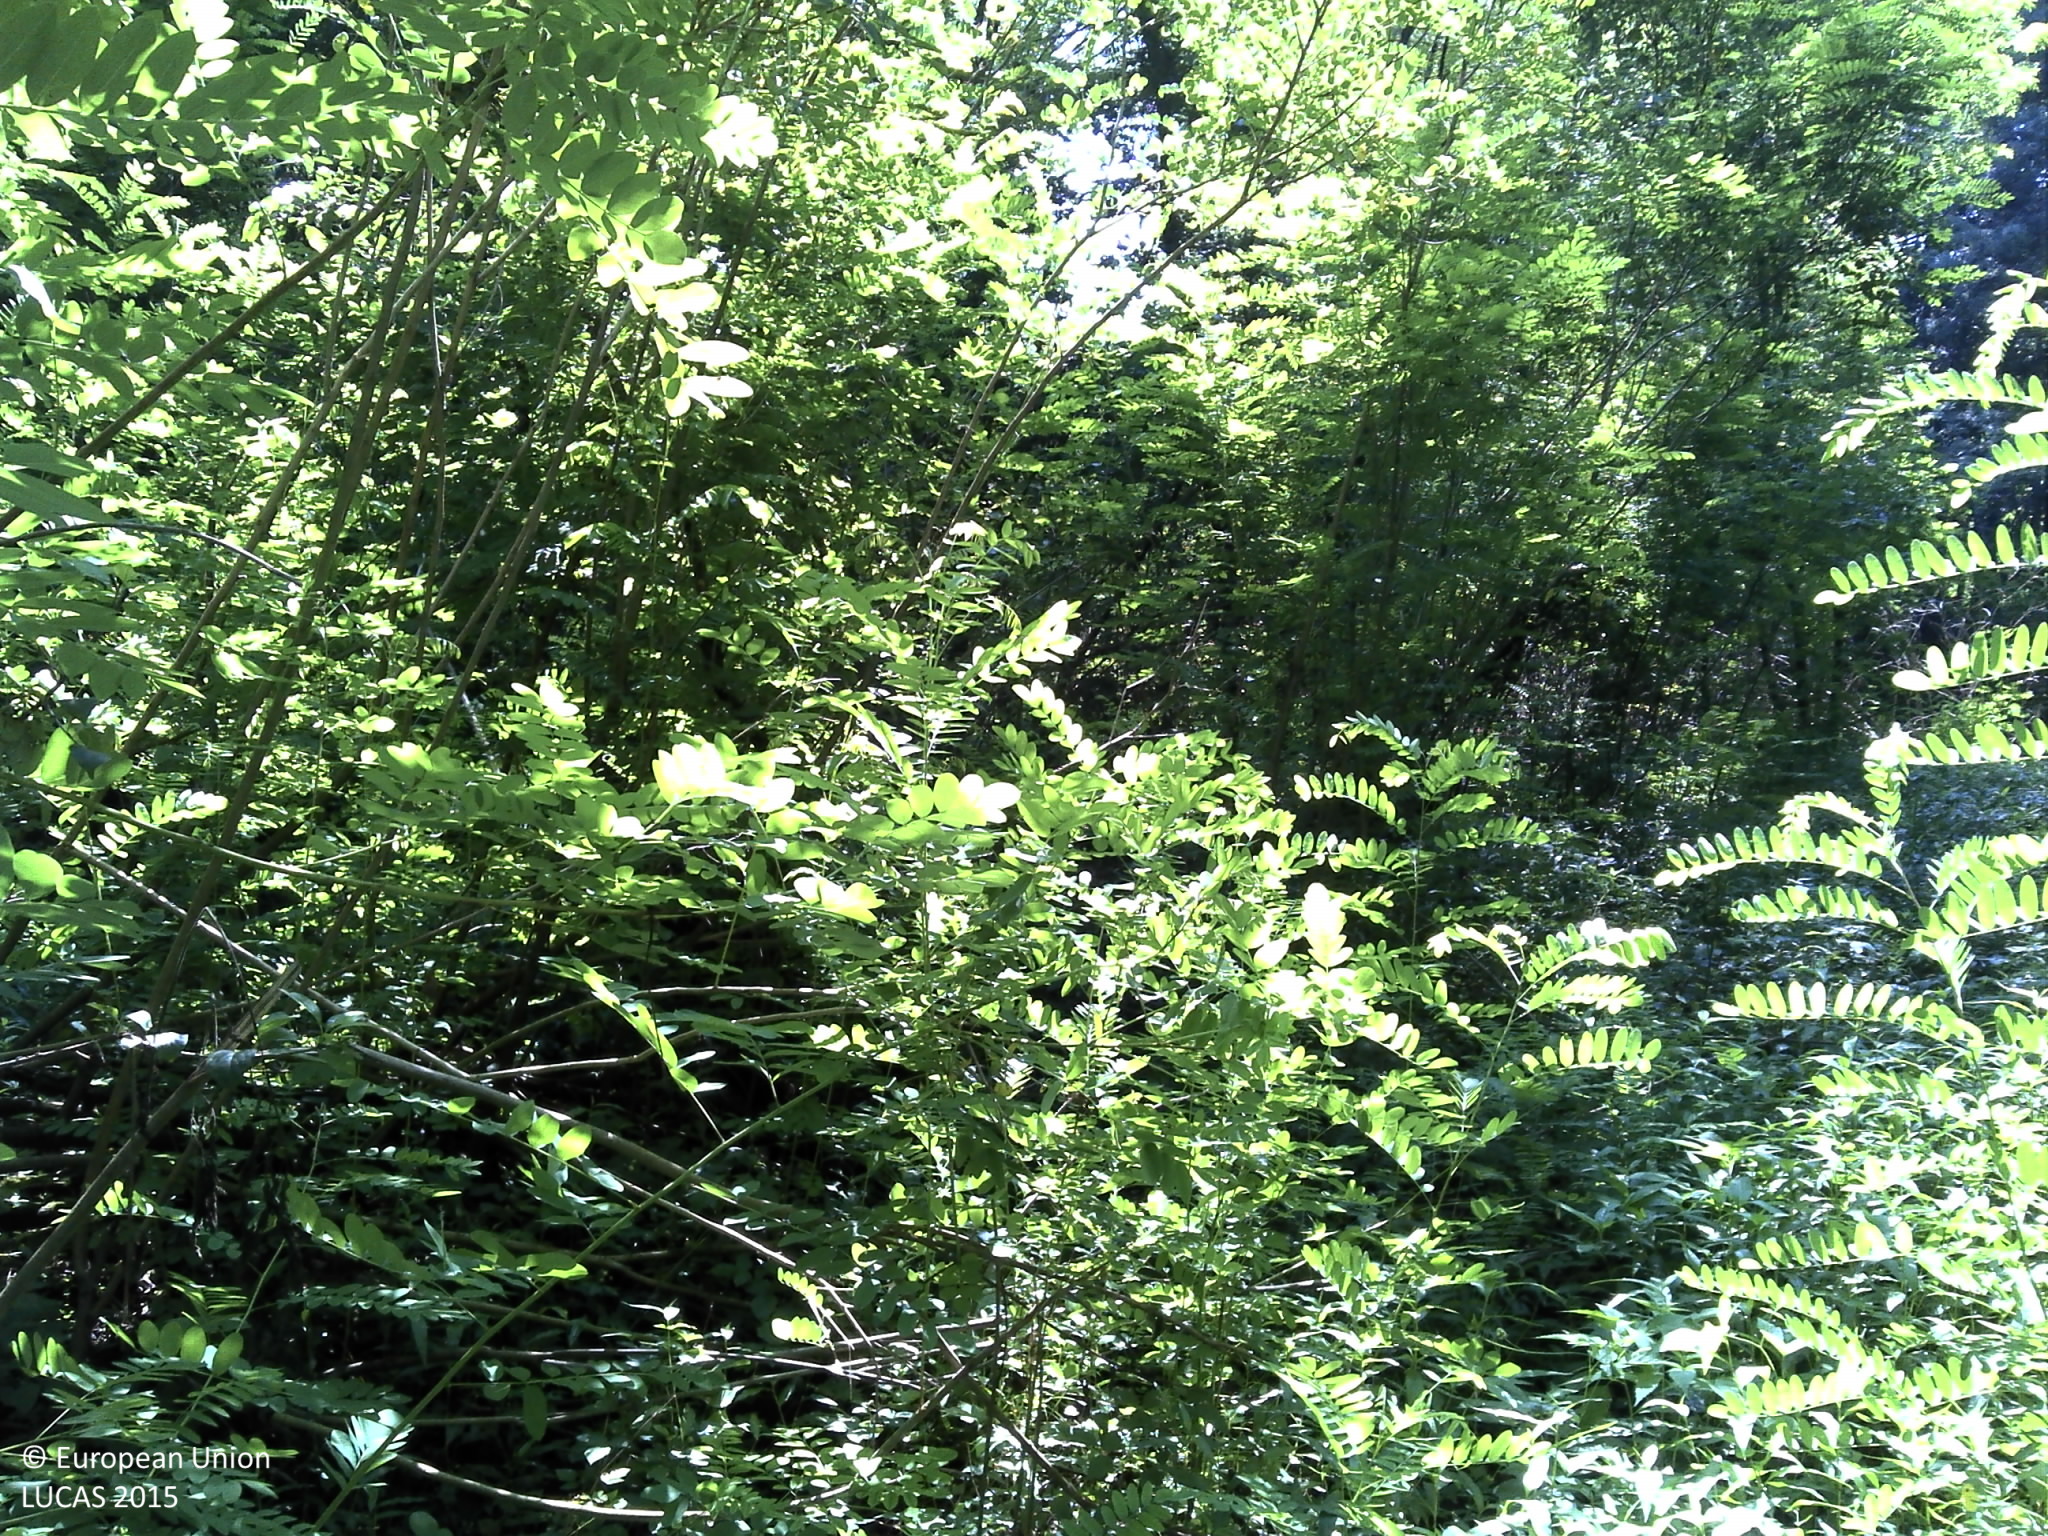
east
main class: Woodland
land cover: Broadleaved woodland
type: acidophilous oak and oak-birch forest
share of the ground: > 75 %
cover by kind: broadleaved forest trees 100 %
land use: Forestry
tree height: > 5 m
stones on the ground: < 10 %
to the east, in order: Broadleaved woodland; Rivers and streams; Shrubland with sparse tree cover; Broadleaved woodland; Tracks
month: August
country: HR
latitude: 45.4176
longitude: 16.7075
